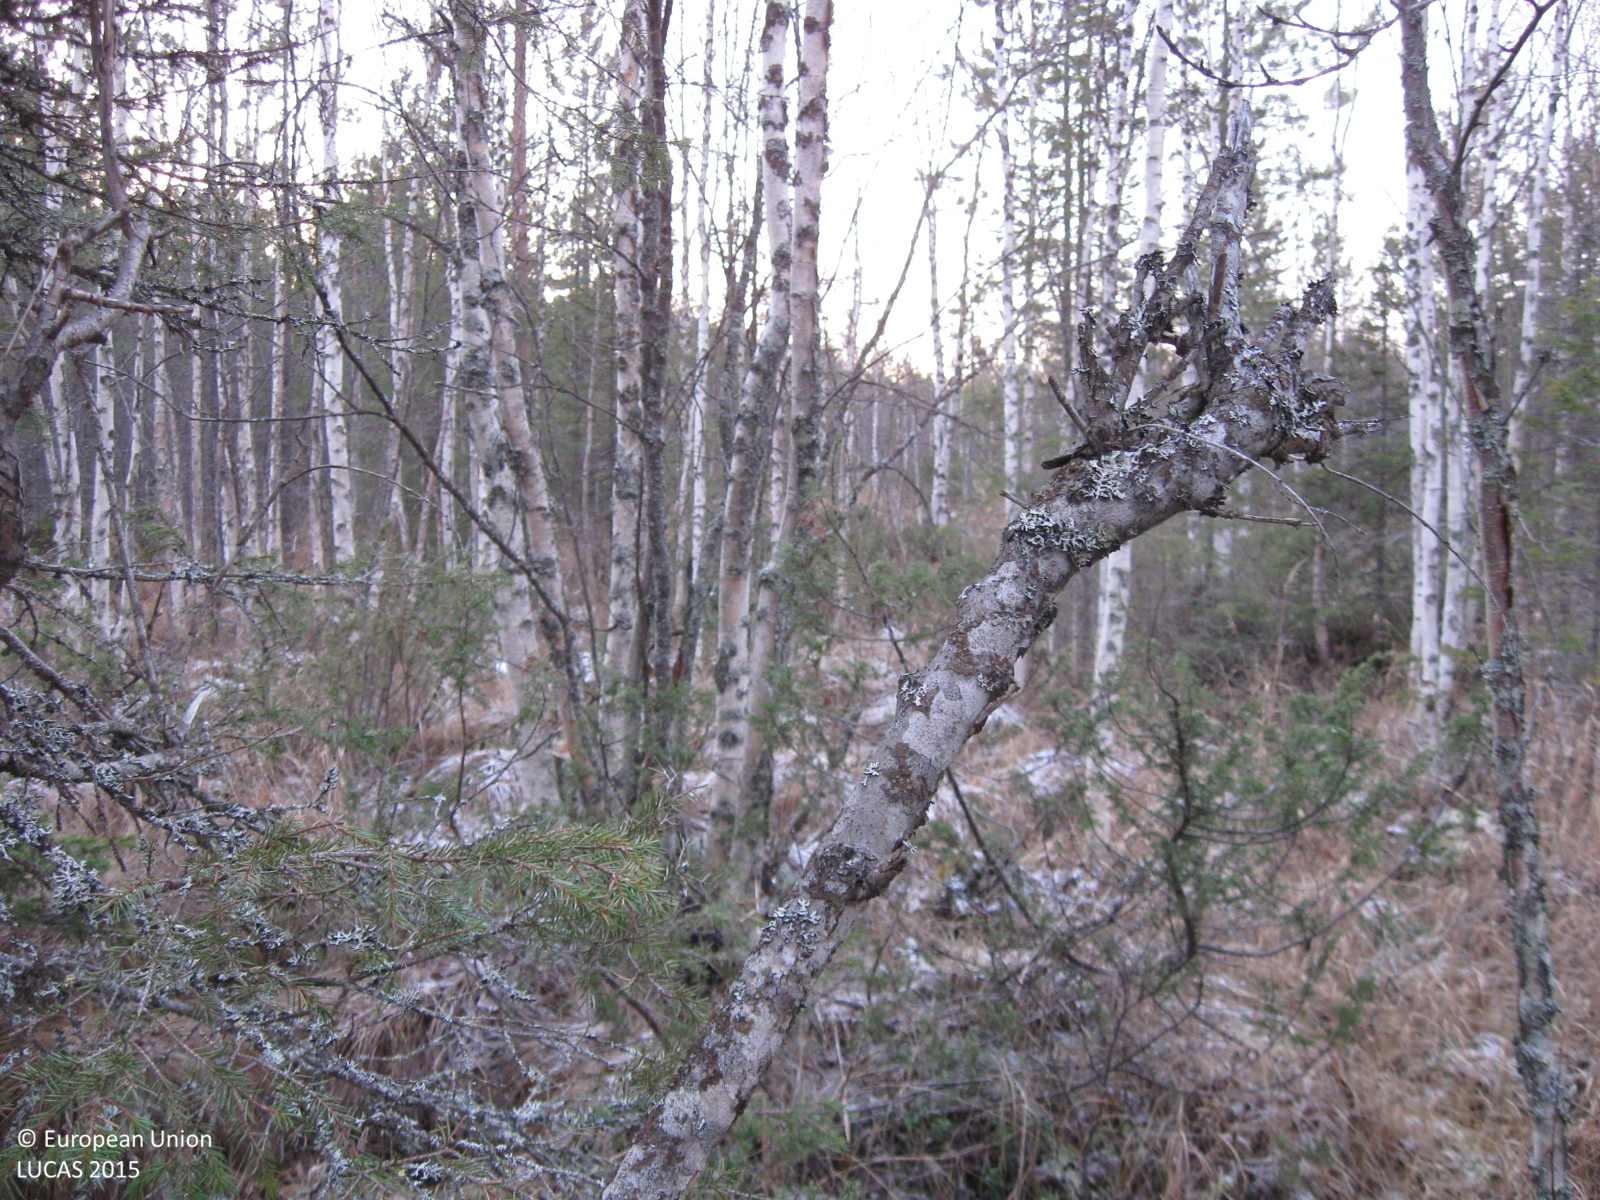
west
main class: Woodland
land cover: Spruce dominated mixed woodland
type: mire and swamp forests
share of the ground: 50 - 75 %
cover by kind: broadleaved forest trees 50 %, coniferous forest trees 20 %, herbaceous plants 20 %, shrubs 5 %, lichens and mosses 5 %
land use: Semi-natural and natural areas not in use
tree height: > 5 m
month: October
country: SE
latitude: 66.1680
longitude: 21.3433
